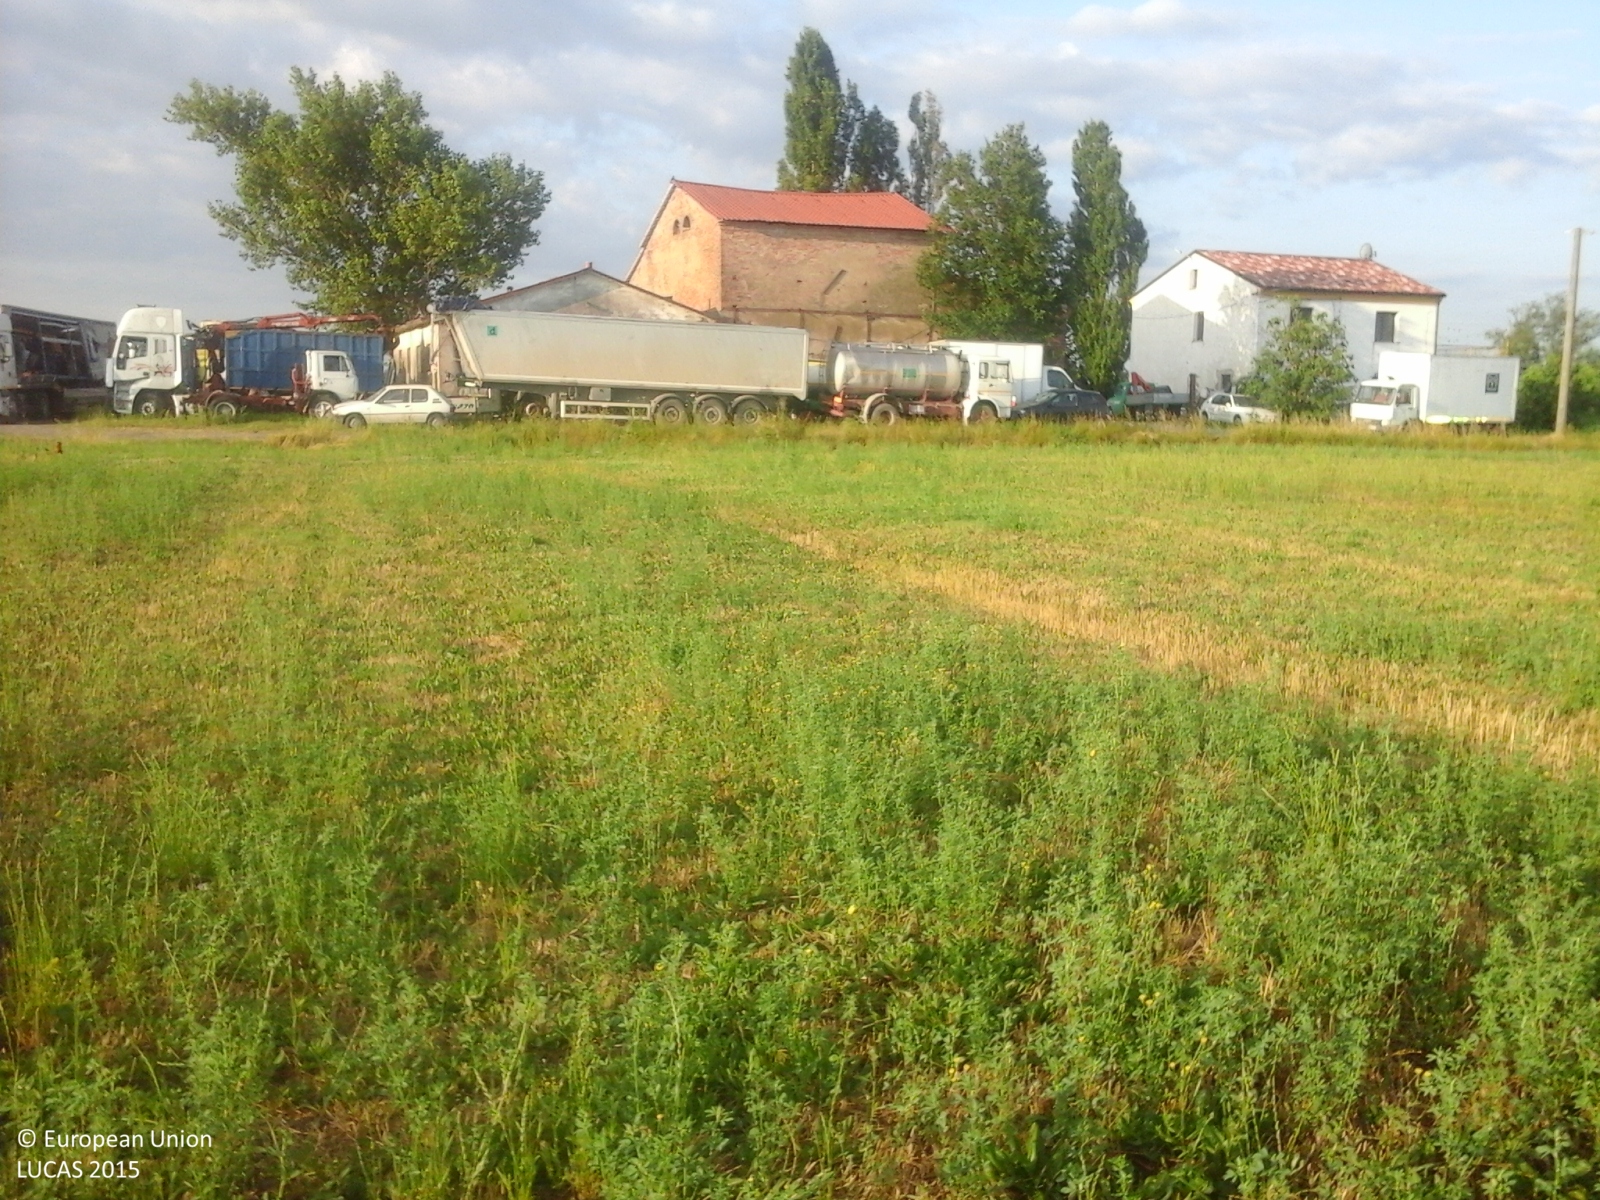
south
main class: Cropland
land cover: Lucerne
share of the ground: > 75 %
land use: Agriculture (excluding fallow land and kitchen gardens)
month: June
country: IT
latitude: 44.9406
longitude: 11.0245
